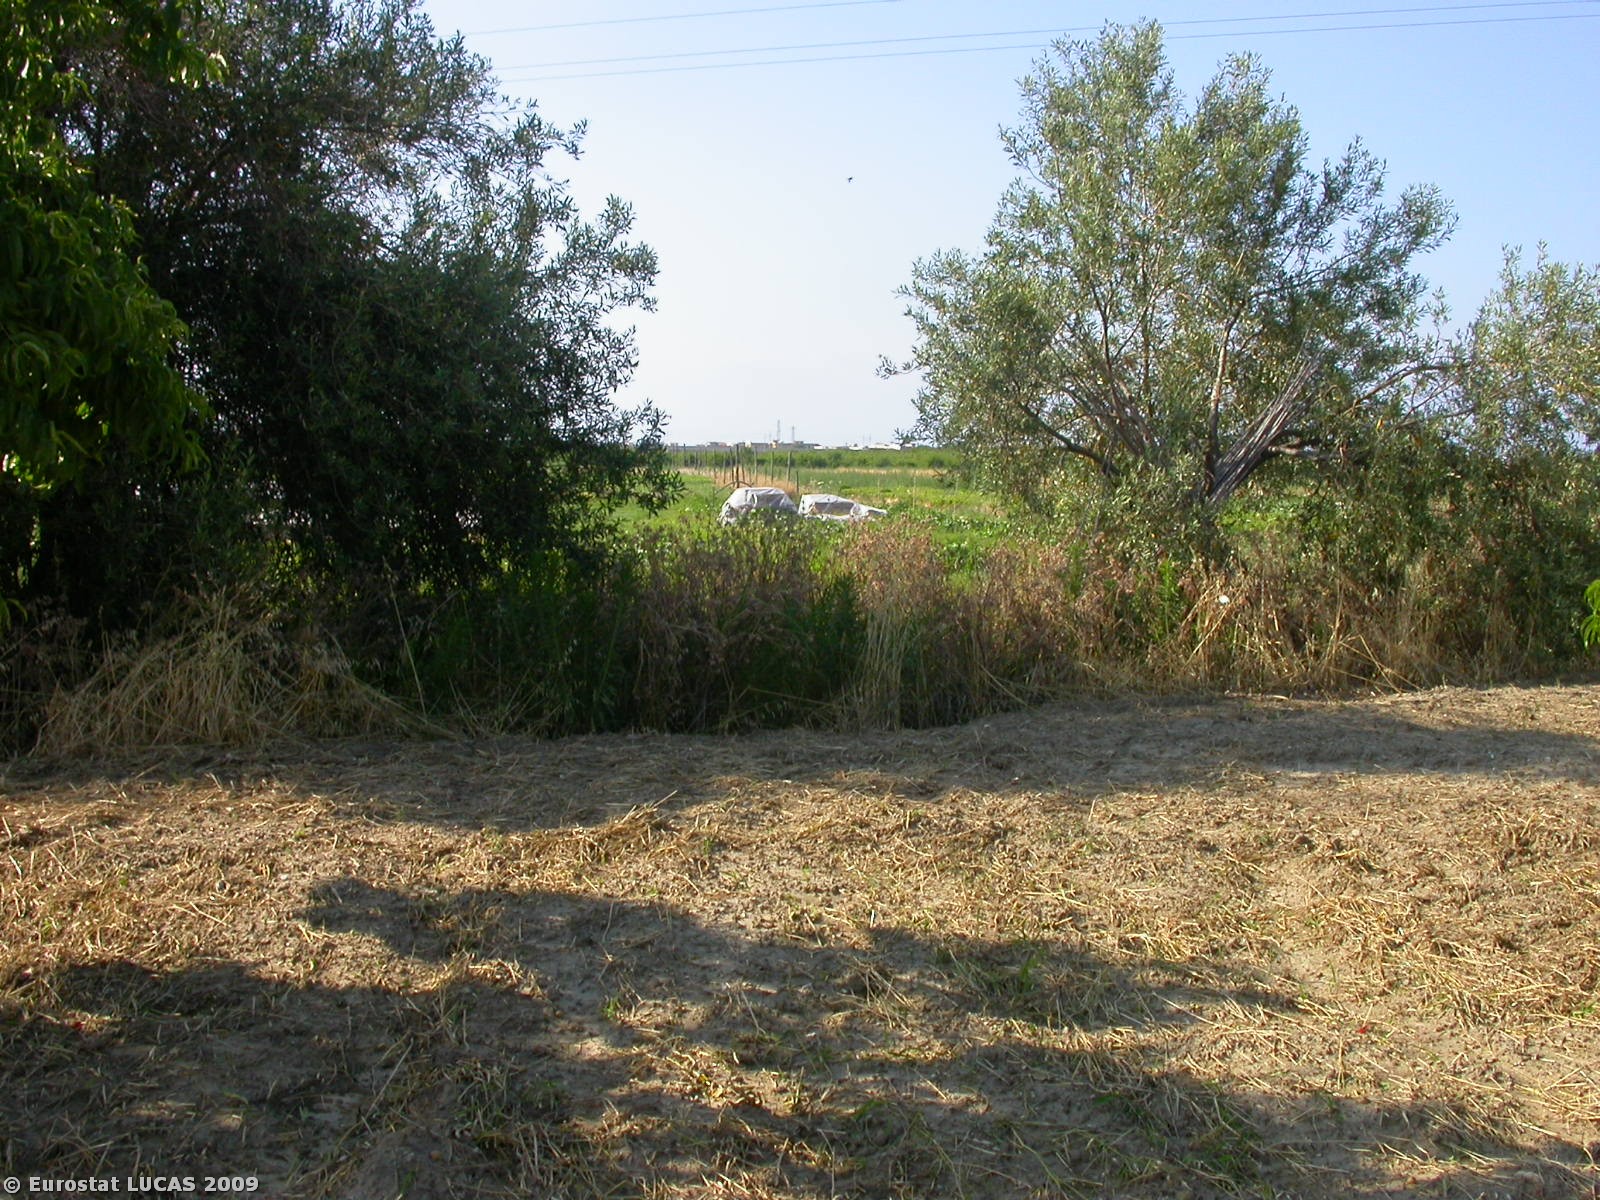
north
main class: Cropland
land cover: Potatoes
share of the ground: < 10 %
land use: Agriculture (excluding fallow land and kitchen gardens)
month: June
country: IT
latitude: 38.1972
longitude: 15.3443
